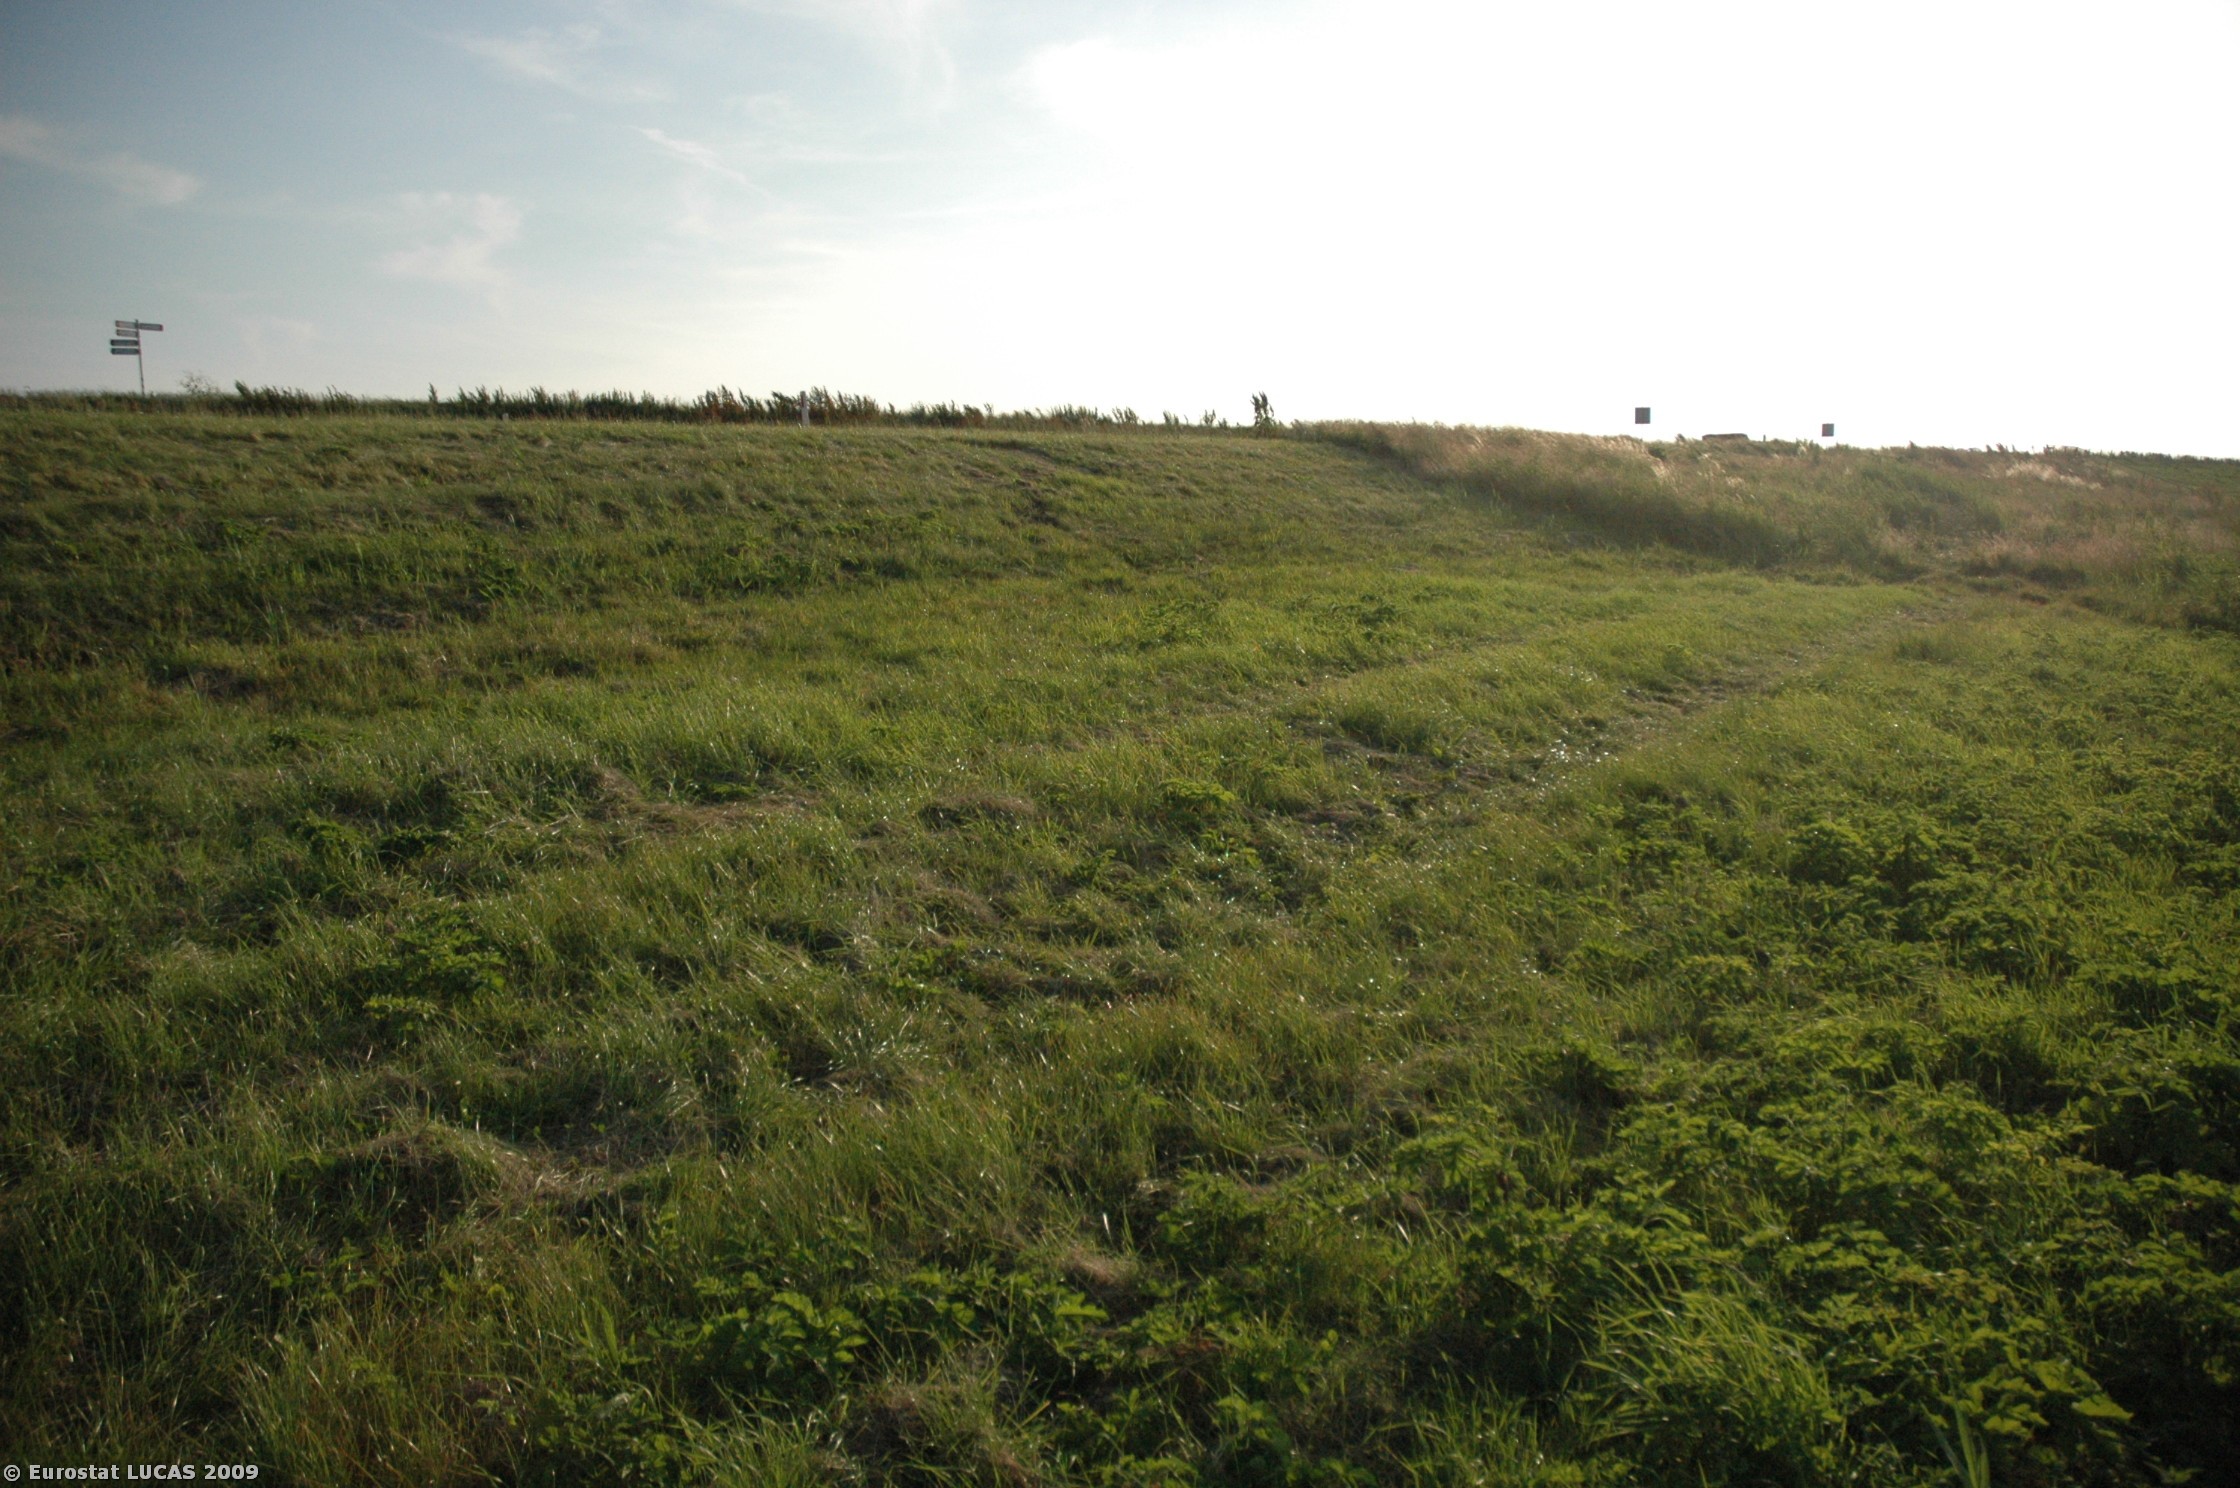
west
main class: Cropland
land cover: Maize
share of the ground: > 75 %
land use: Agriculture (excluding fallow land and kitchen gardens)
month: June
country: NL
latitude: 52.2697
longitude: 5.3821
